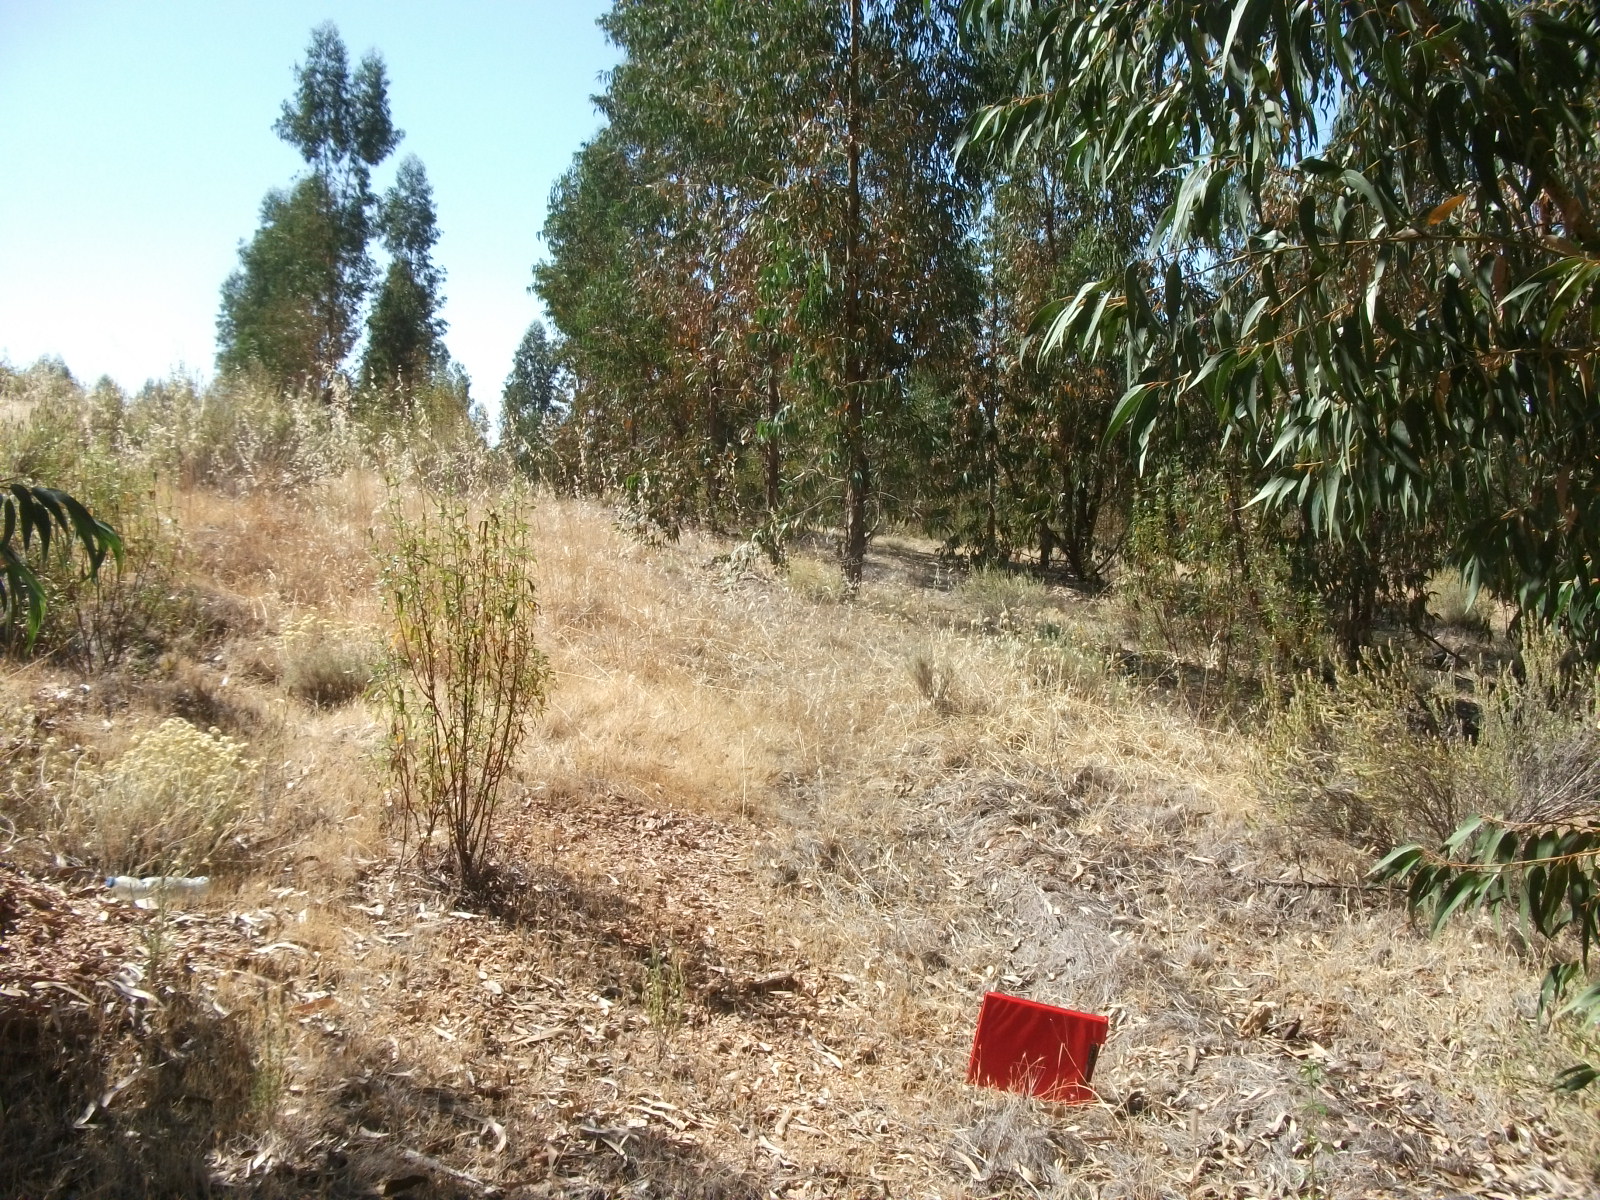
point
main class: Woodland
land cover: Broadleaved woodland
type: exotic forest
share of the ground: 50 - 75 %
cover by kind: broadleaved forest trees 70 %, herbaceous plants 20 %, shrubs 10 %
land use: Forestry
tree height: > 5 m
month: June
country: ES
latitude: 37.6513
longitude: -6.9689
